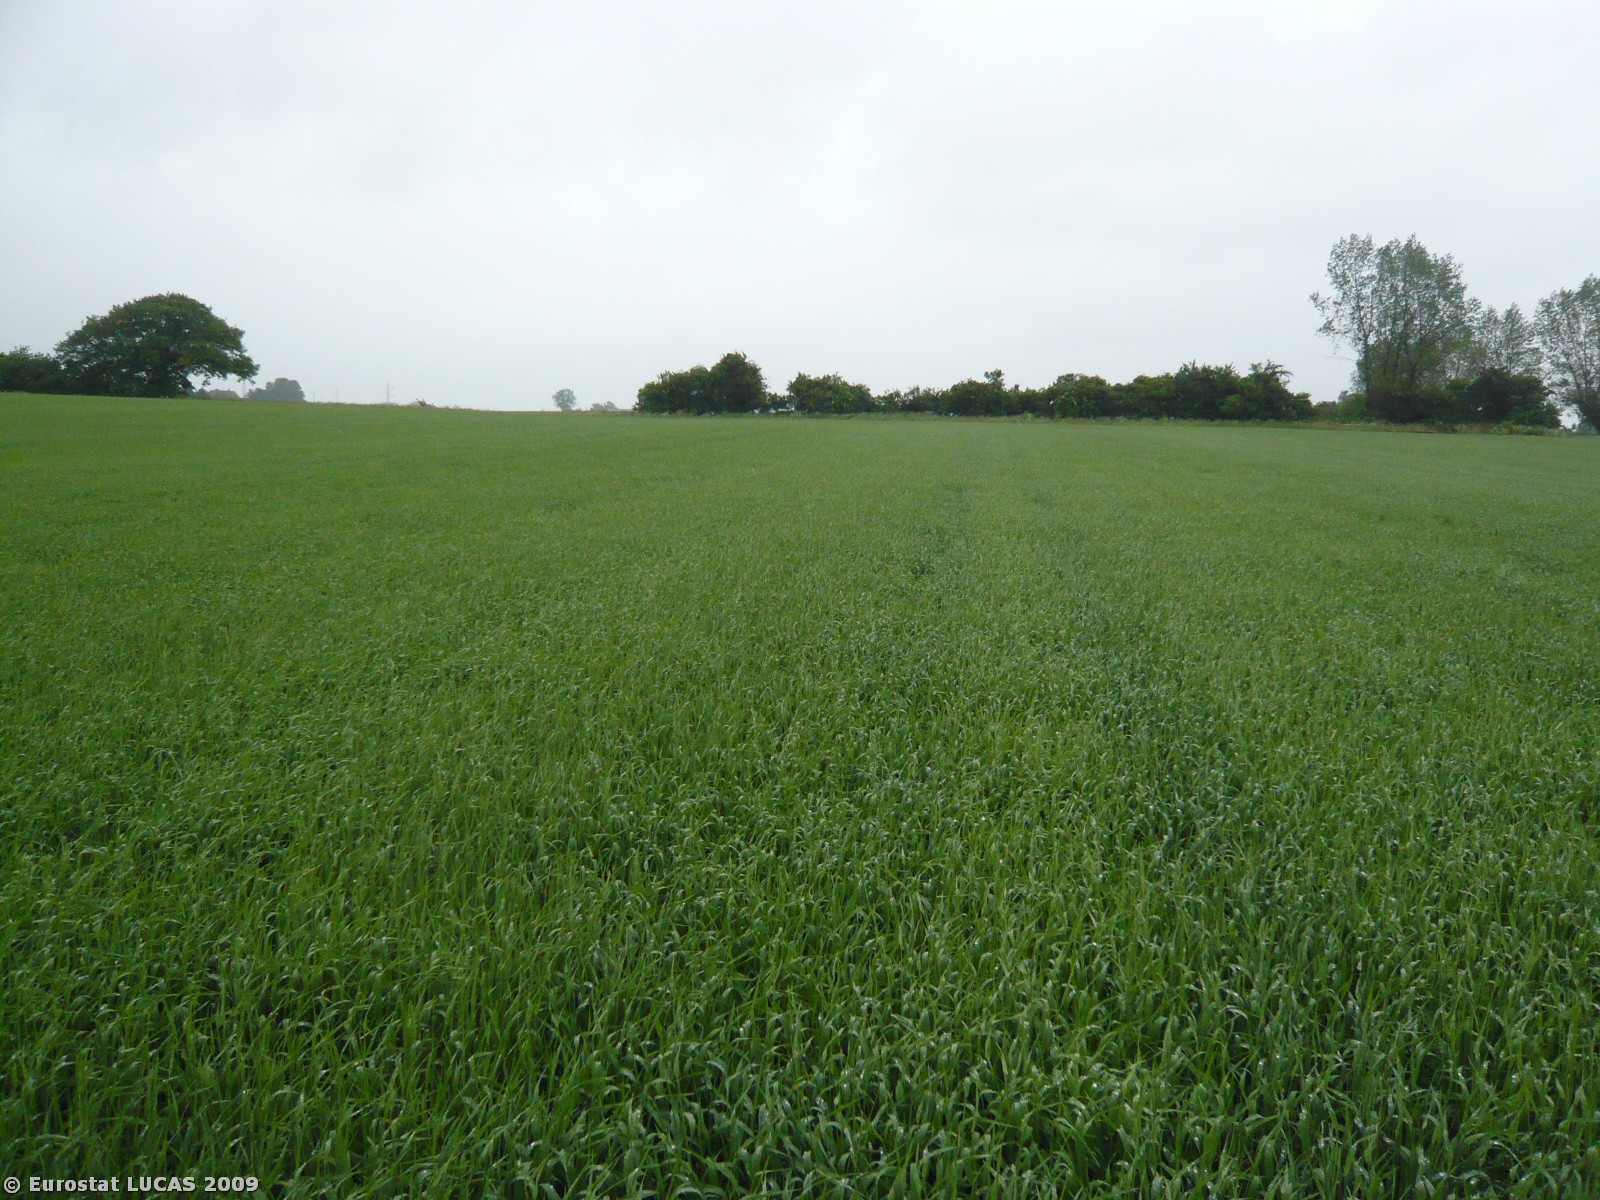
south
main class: Cropland
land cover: Barley
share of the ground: > 75 %
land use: Agriculture (excluding fallow land and kitchen gardens)
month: June
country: DK
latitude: 54.7891
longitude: 11.9116
